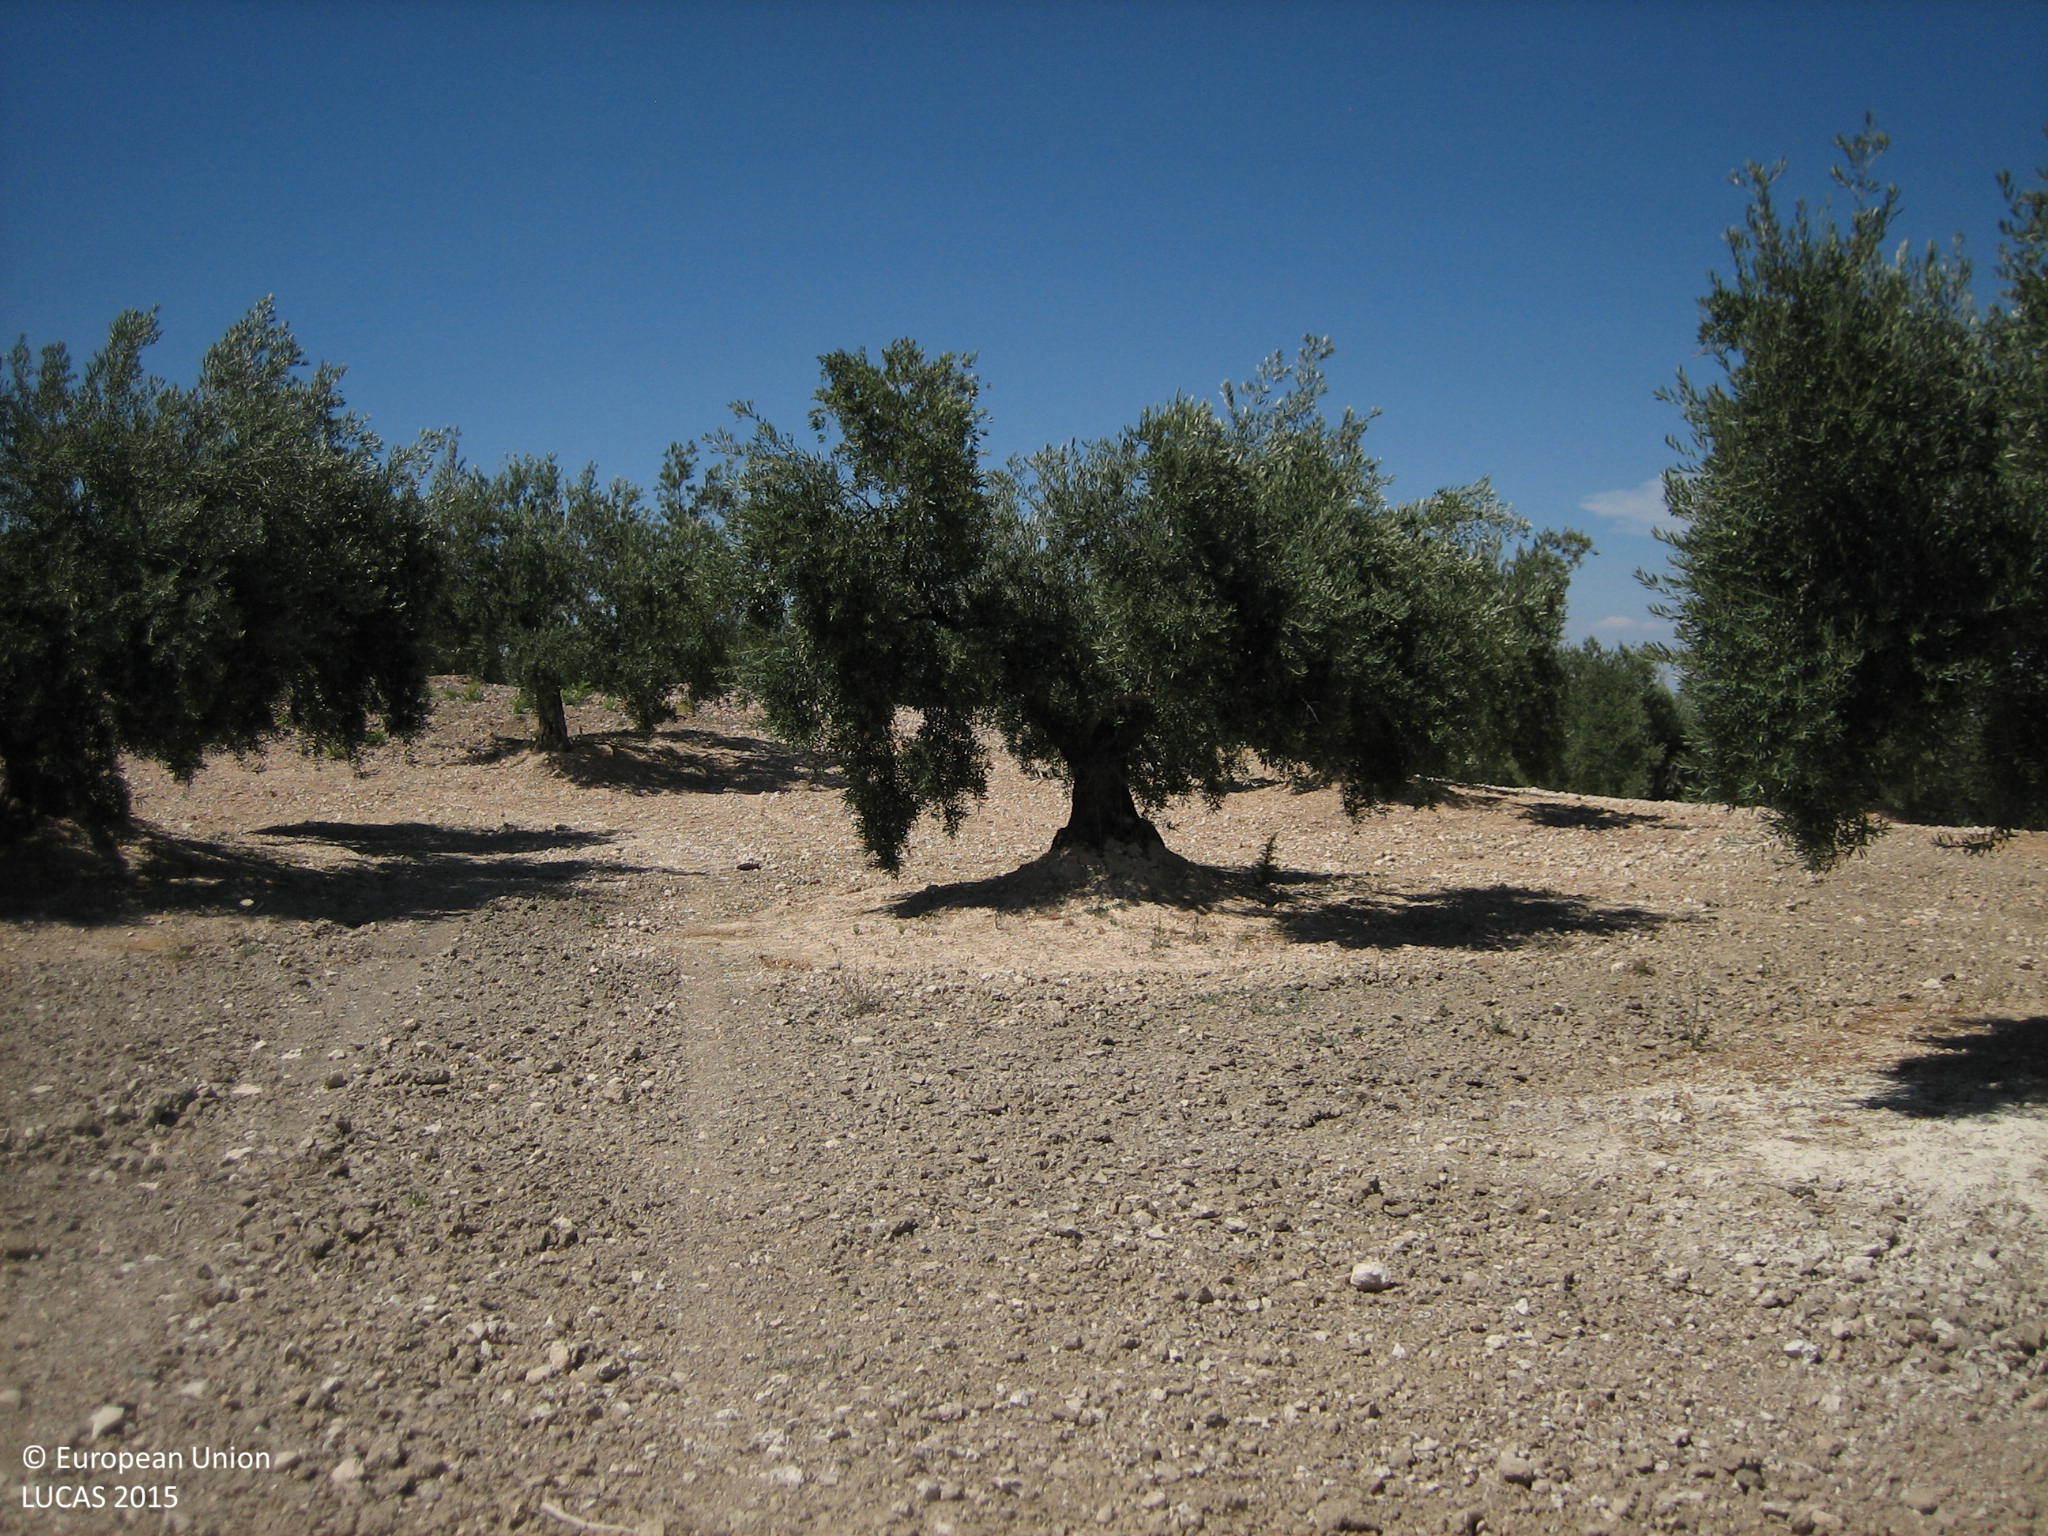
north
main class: Cropland
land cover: Olive groves
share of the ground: 25 - 50 %
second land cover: Other bare soil
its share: > 75 %
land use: Agriculture (excluding fallow land and kitchen gardens)
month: June
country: ES
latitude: 37.7299
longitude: -3.7858
